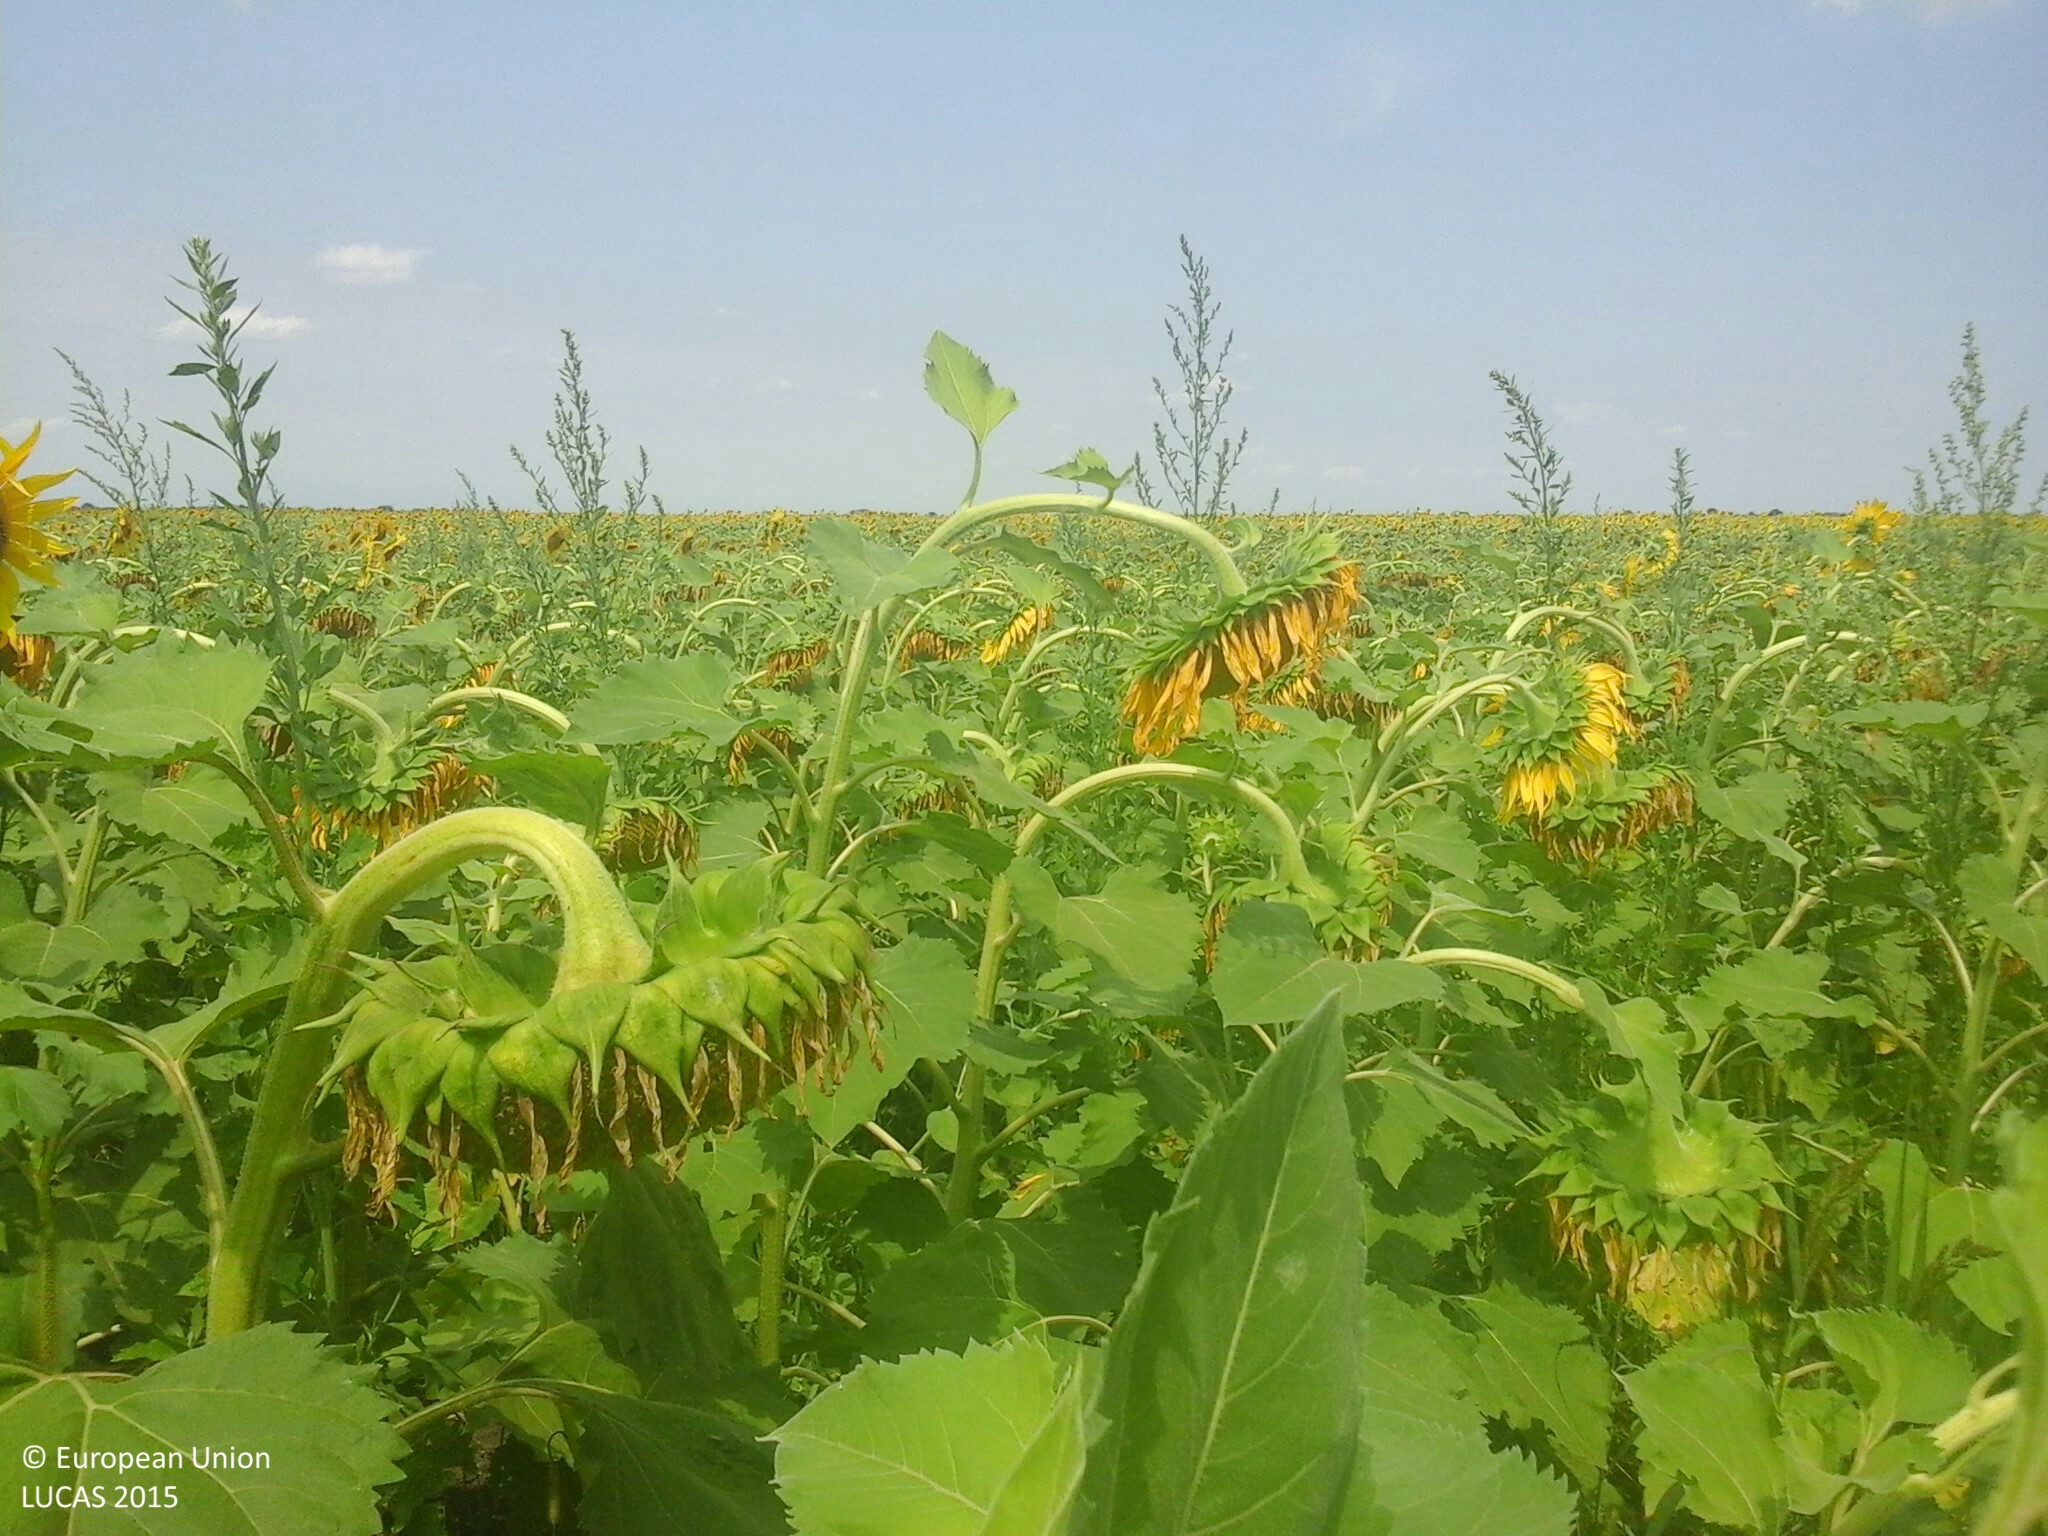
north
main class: Cropland
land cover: Sunflower
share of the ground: > 75 %
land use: Agriculture (excluding fallow land and kitchen gardens)
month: July
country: HU
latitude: 46.7974
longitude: 20.0992
